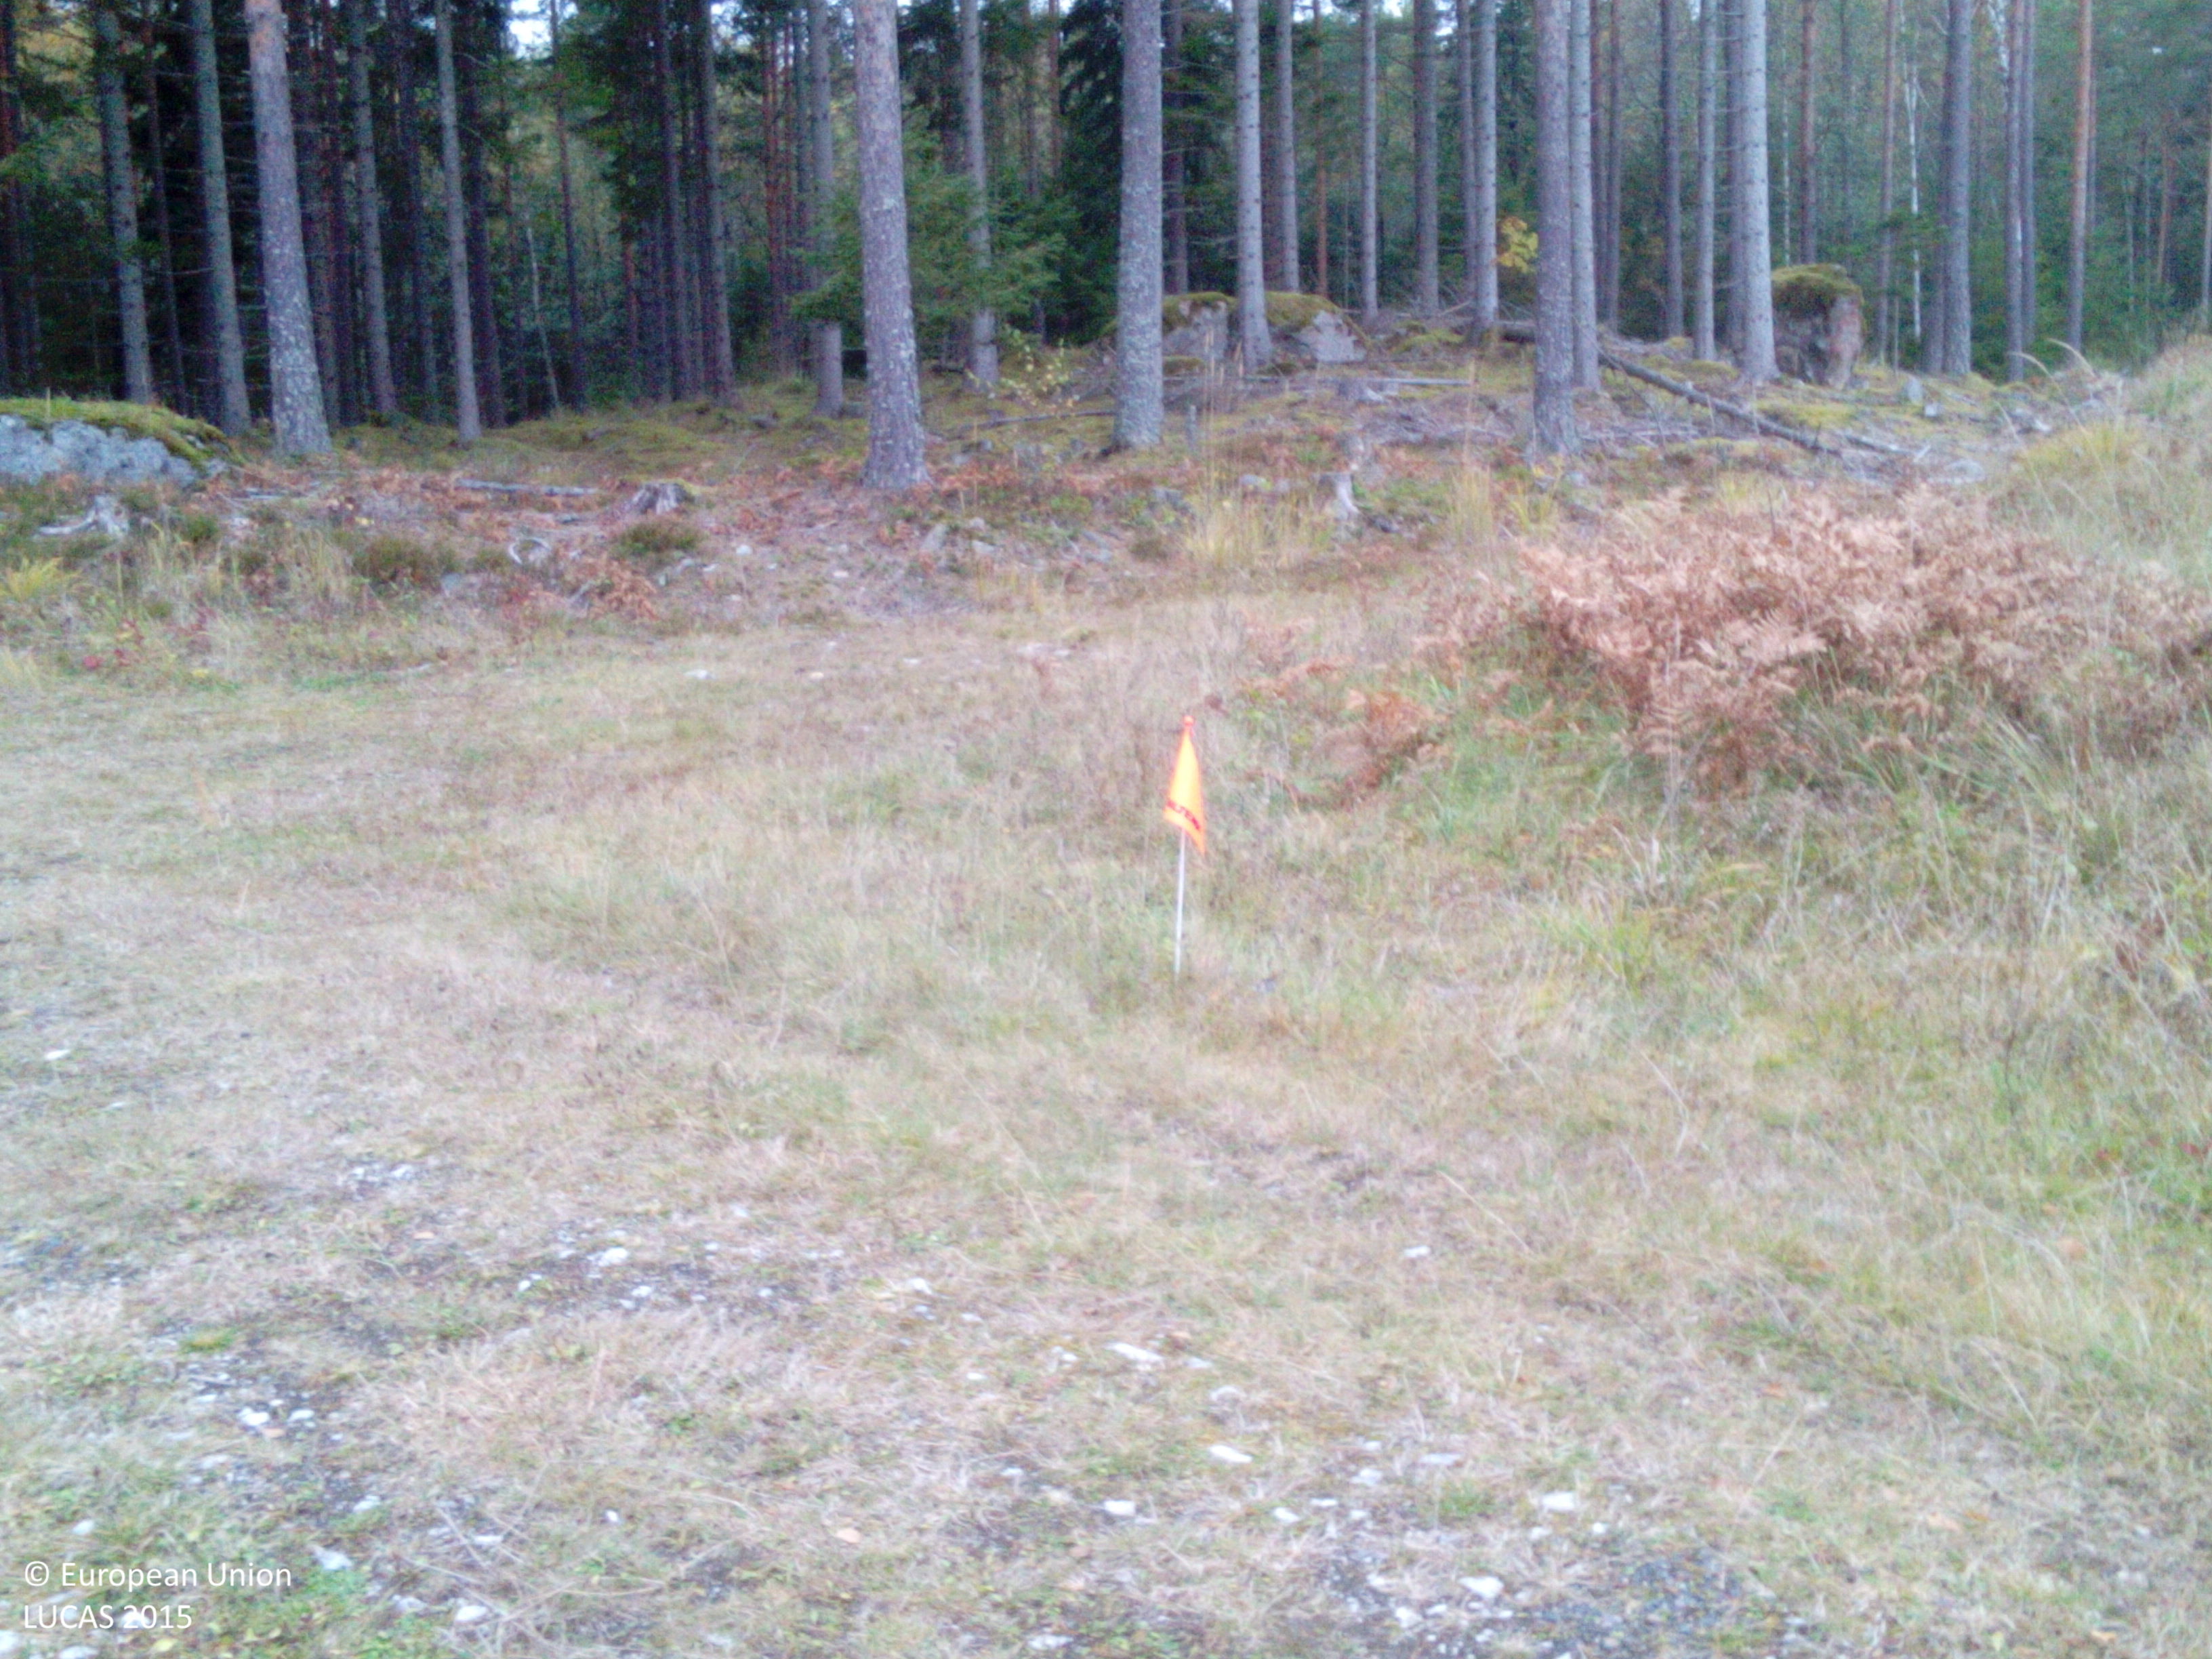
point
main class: Grassland
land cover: Grassland without tree/shrub cover
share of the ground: > 75 %
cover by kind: herbaceous plants 100 %
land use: Semi-natural and natural areas not in use
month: October
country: SE
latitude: 58.8081
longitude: 16.3826
